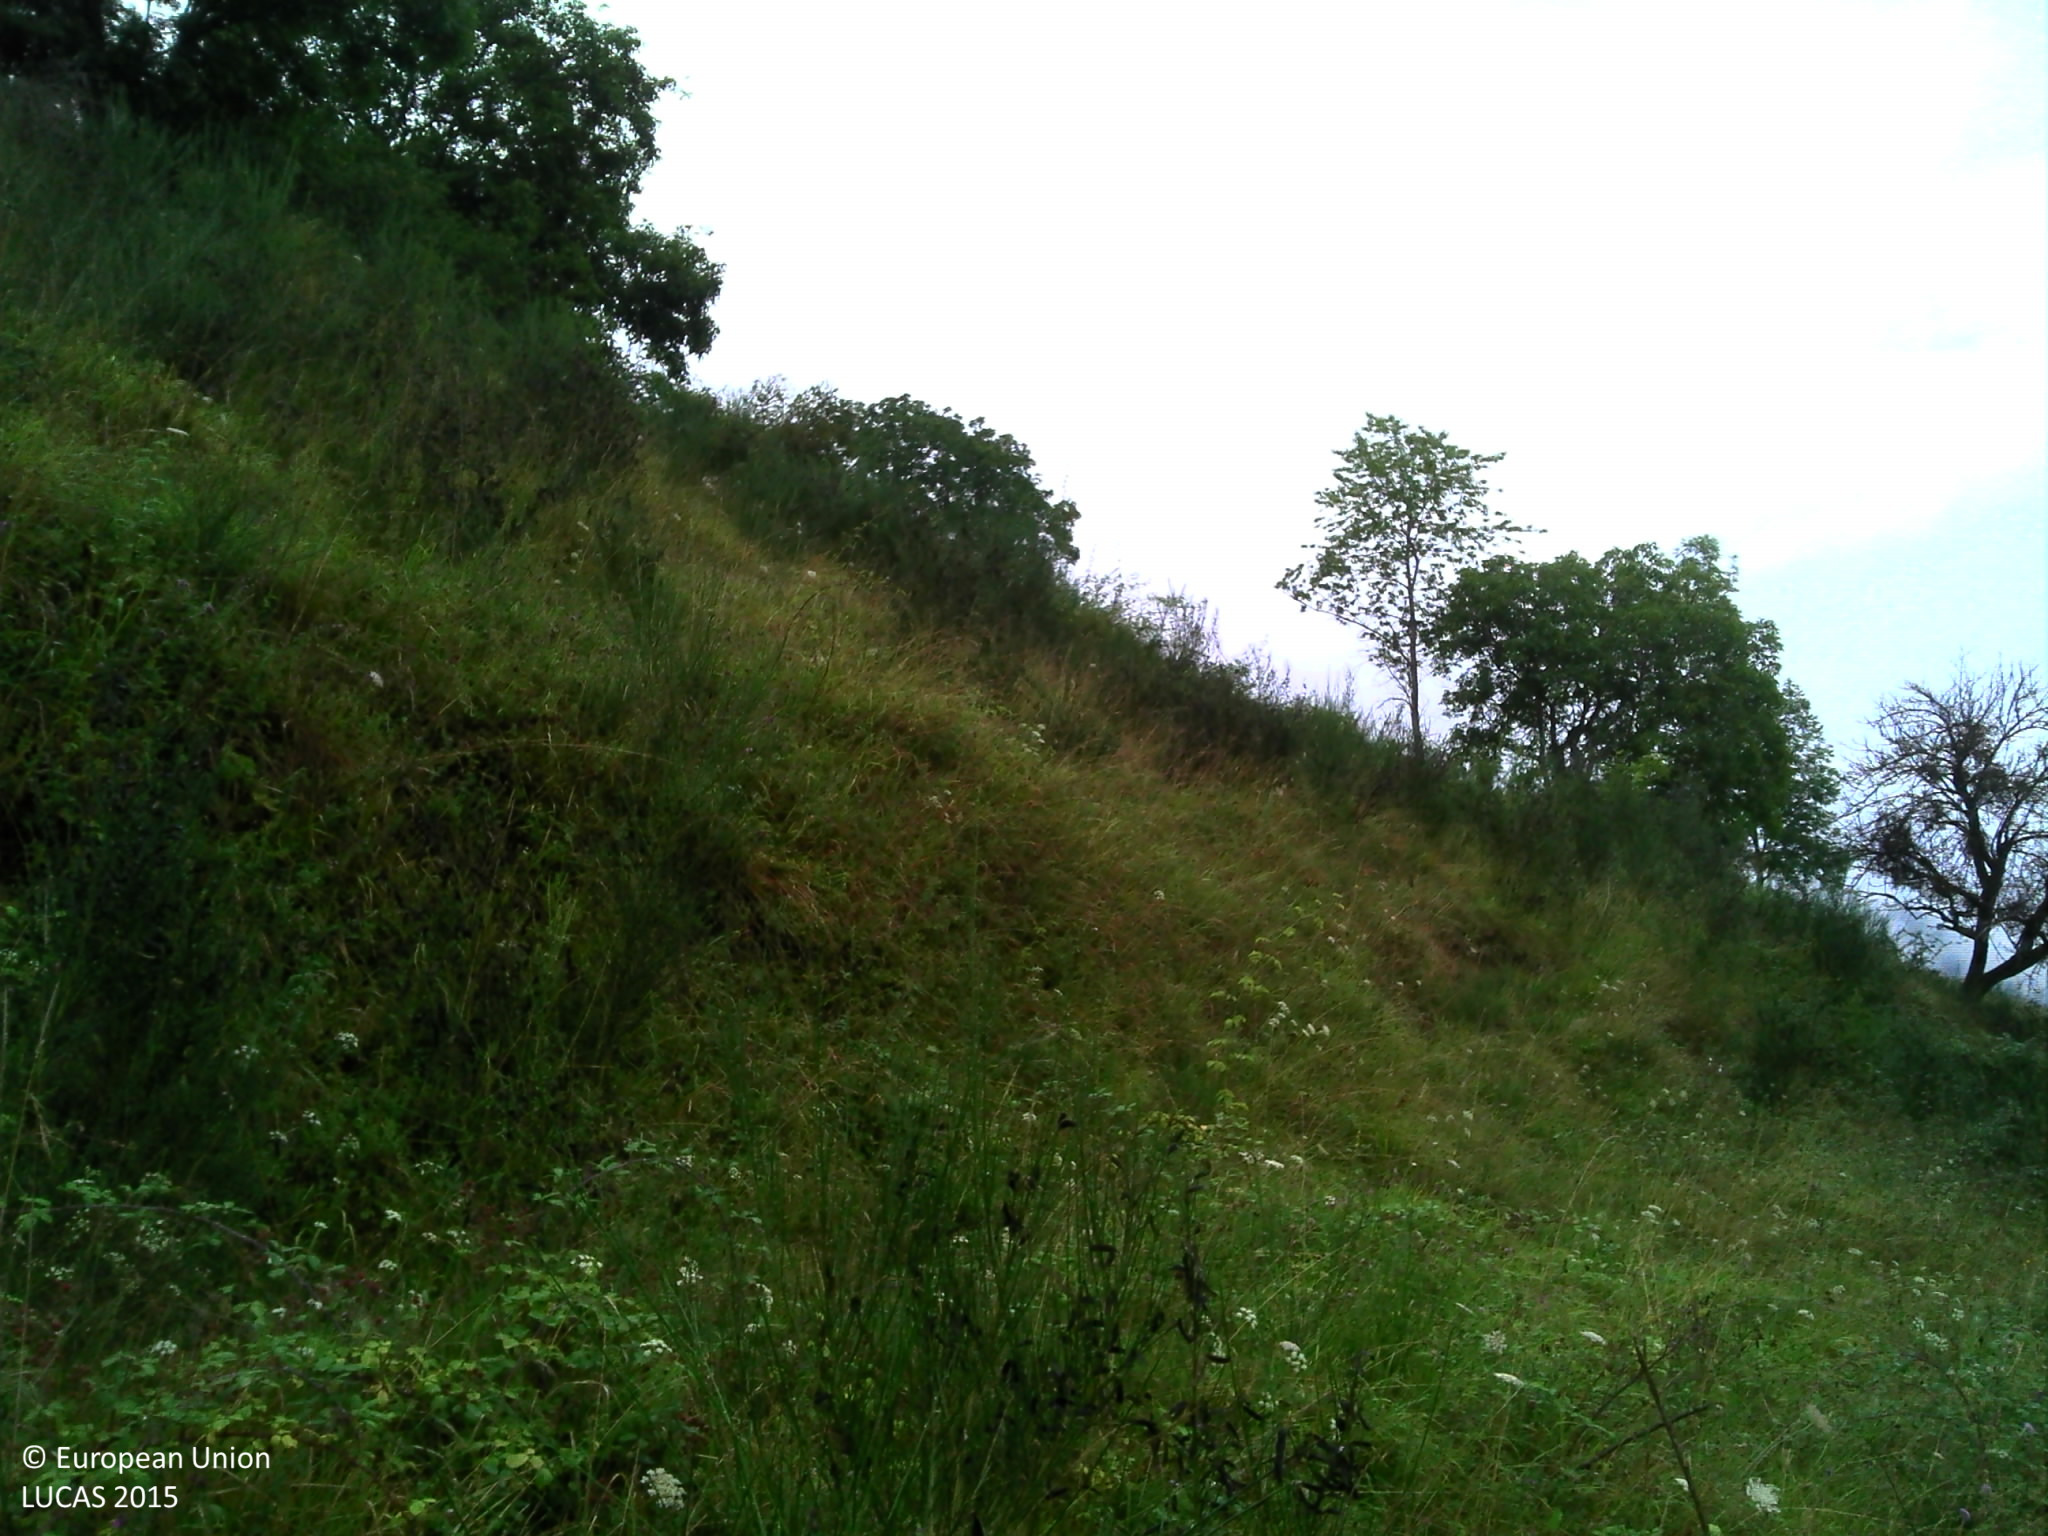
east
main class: Grassland
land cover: Spontaneously vegetated surfaces
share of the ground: > 75 %
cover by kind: herbaceous plants 100 %
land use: Semi-natural and natural areas not in use
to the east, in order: Spontaneously vegetated surfaces; Fences; Grass margins; Tracks; Ditches and canals; Spontaneously vegetated surfaces; Ditches and canals; Grass margins; Tracks; Grass margins; Fences; Grassland without tree/shrub cover; Single bushes/trees; Fences; Grass margins; Tracks; Ditches and canals; Grassland with sparse tree/shrub cover; Fences; Managed hedges
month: August
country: FR
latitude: 42.8929
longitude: 1.0535
